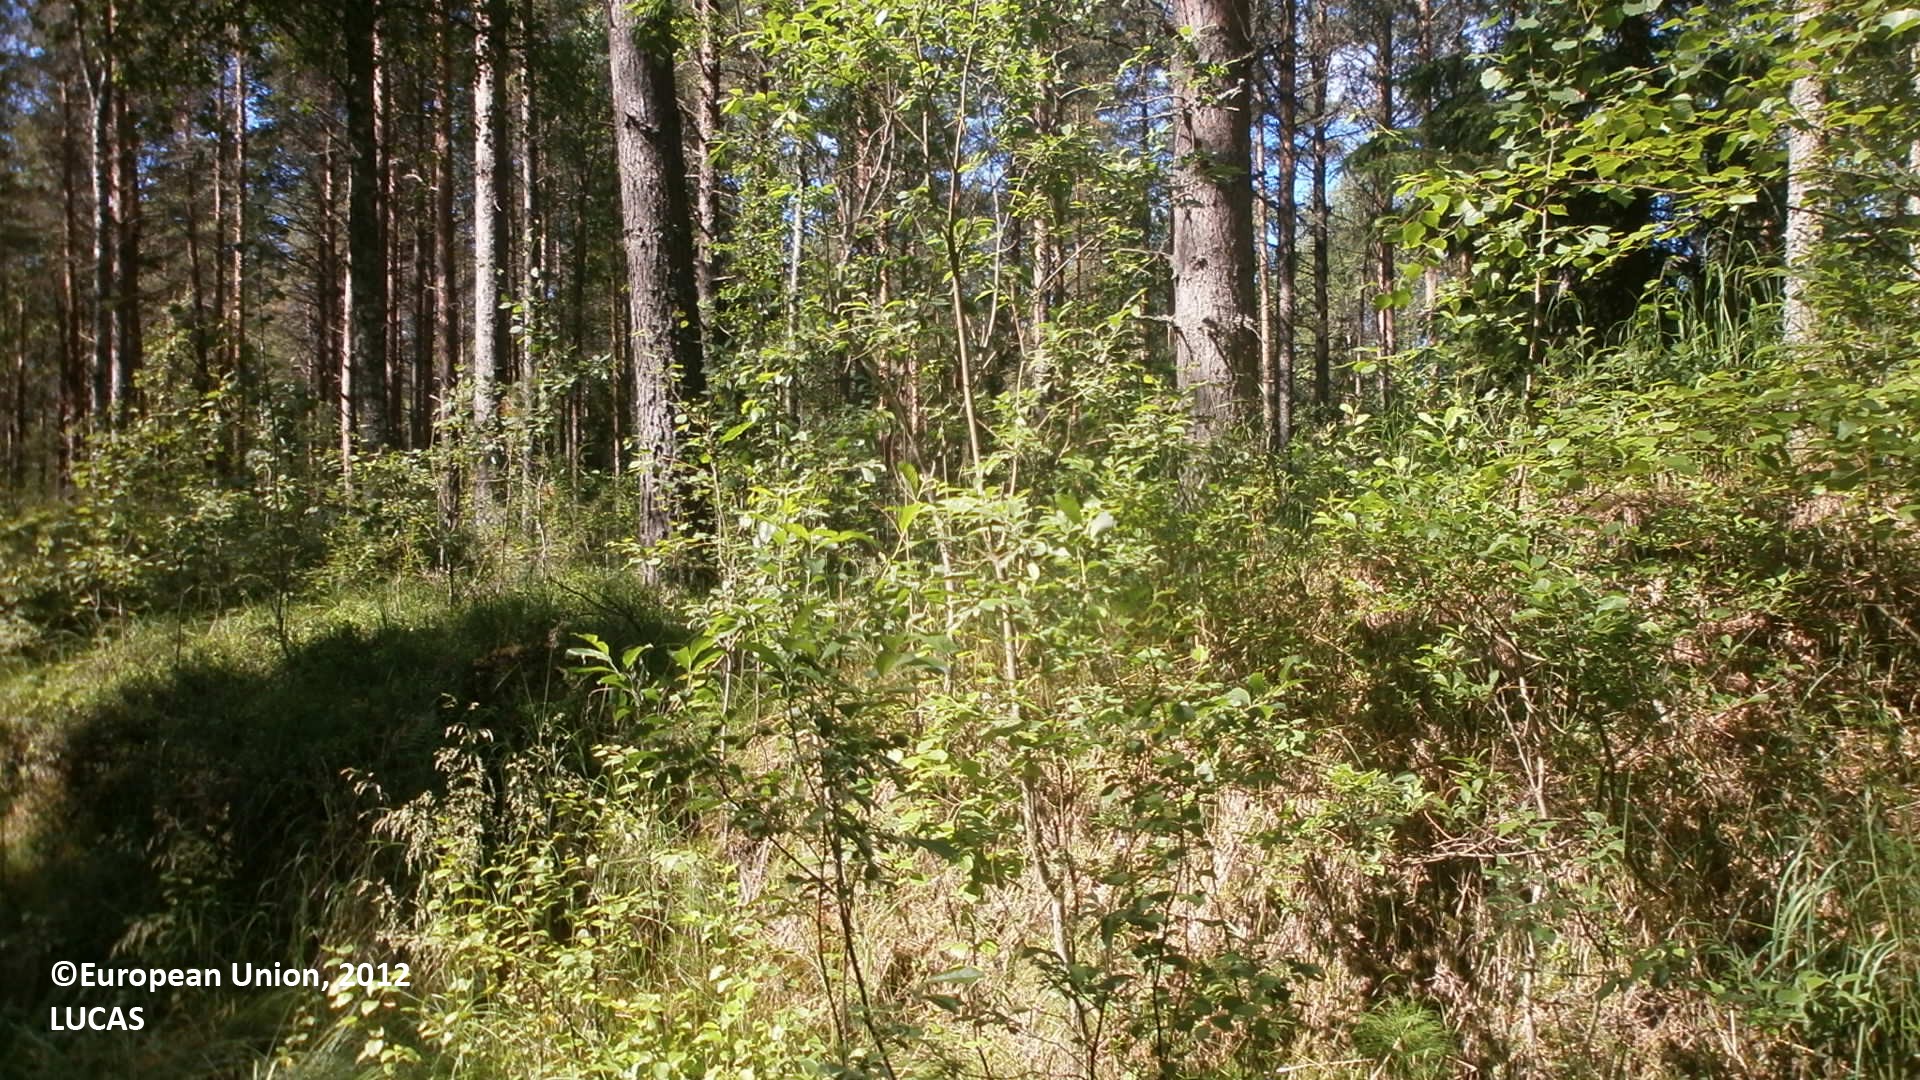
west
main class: Woodland
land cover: Pine dominated coniferous woodland
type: boreal forest
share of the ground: > 75 %
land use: Forestry
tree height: > 5 m
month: July
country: FI
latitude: 64.2950
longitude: 24.1368
